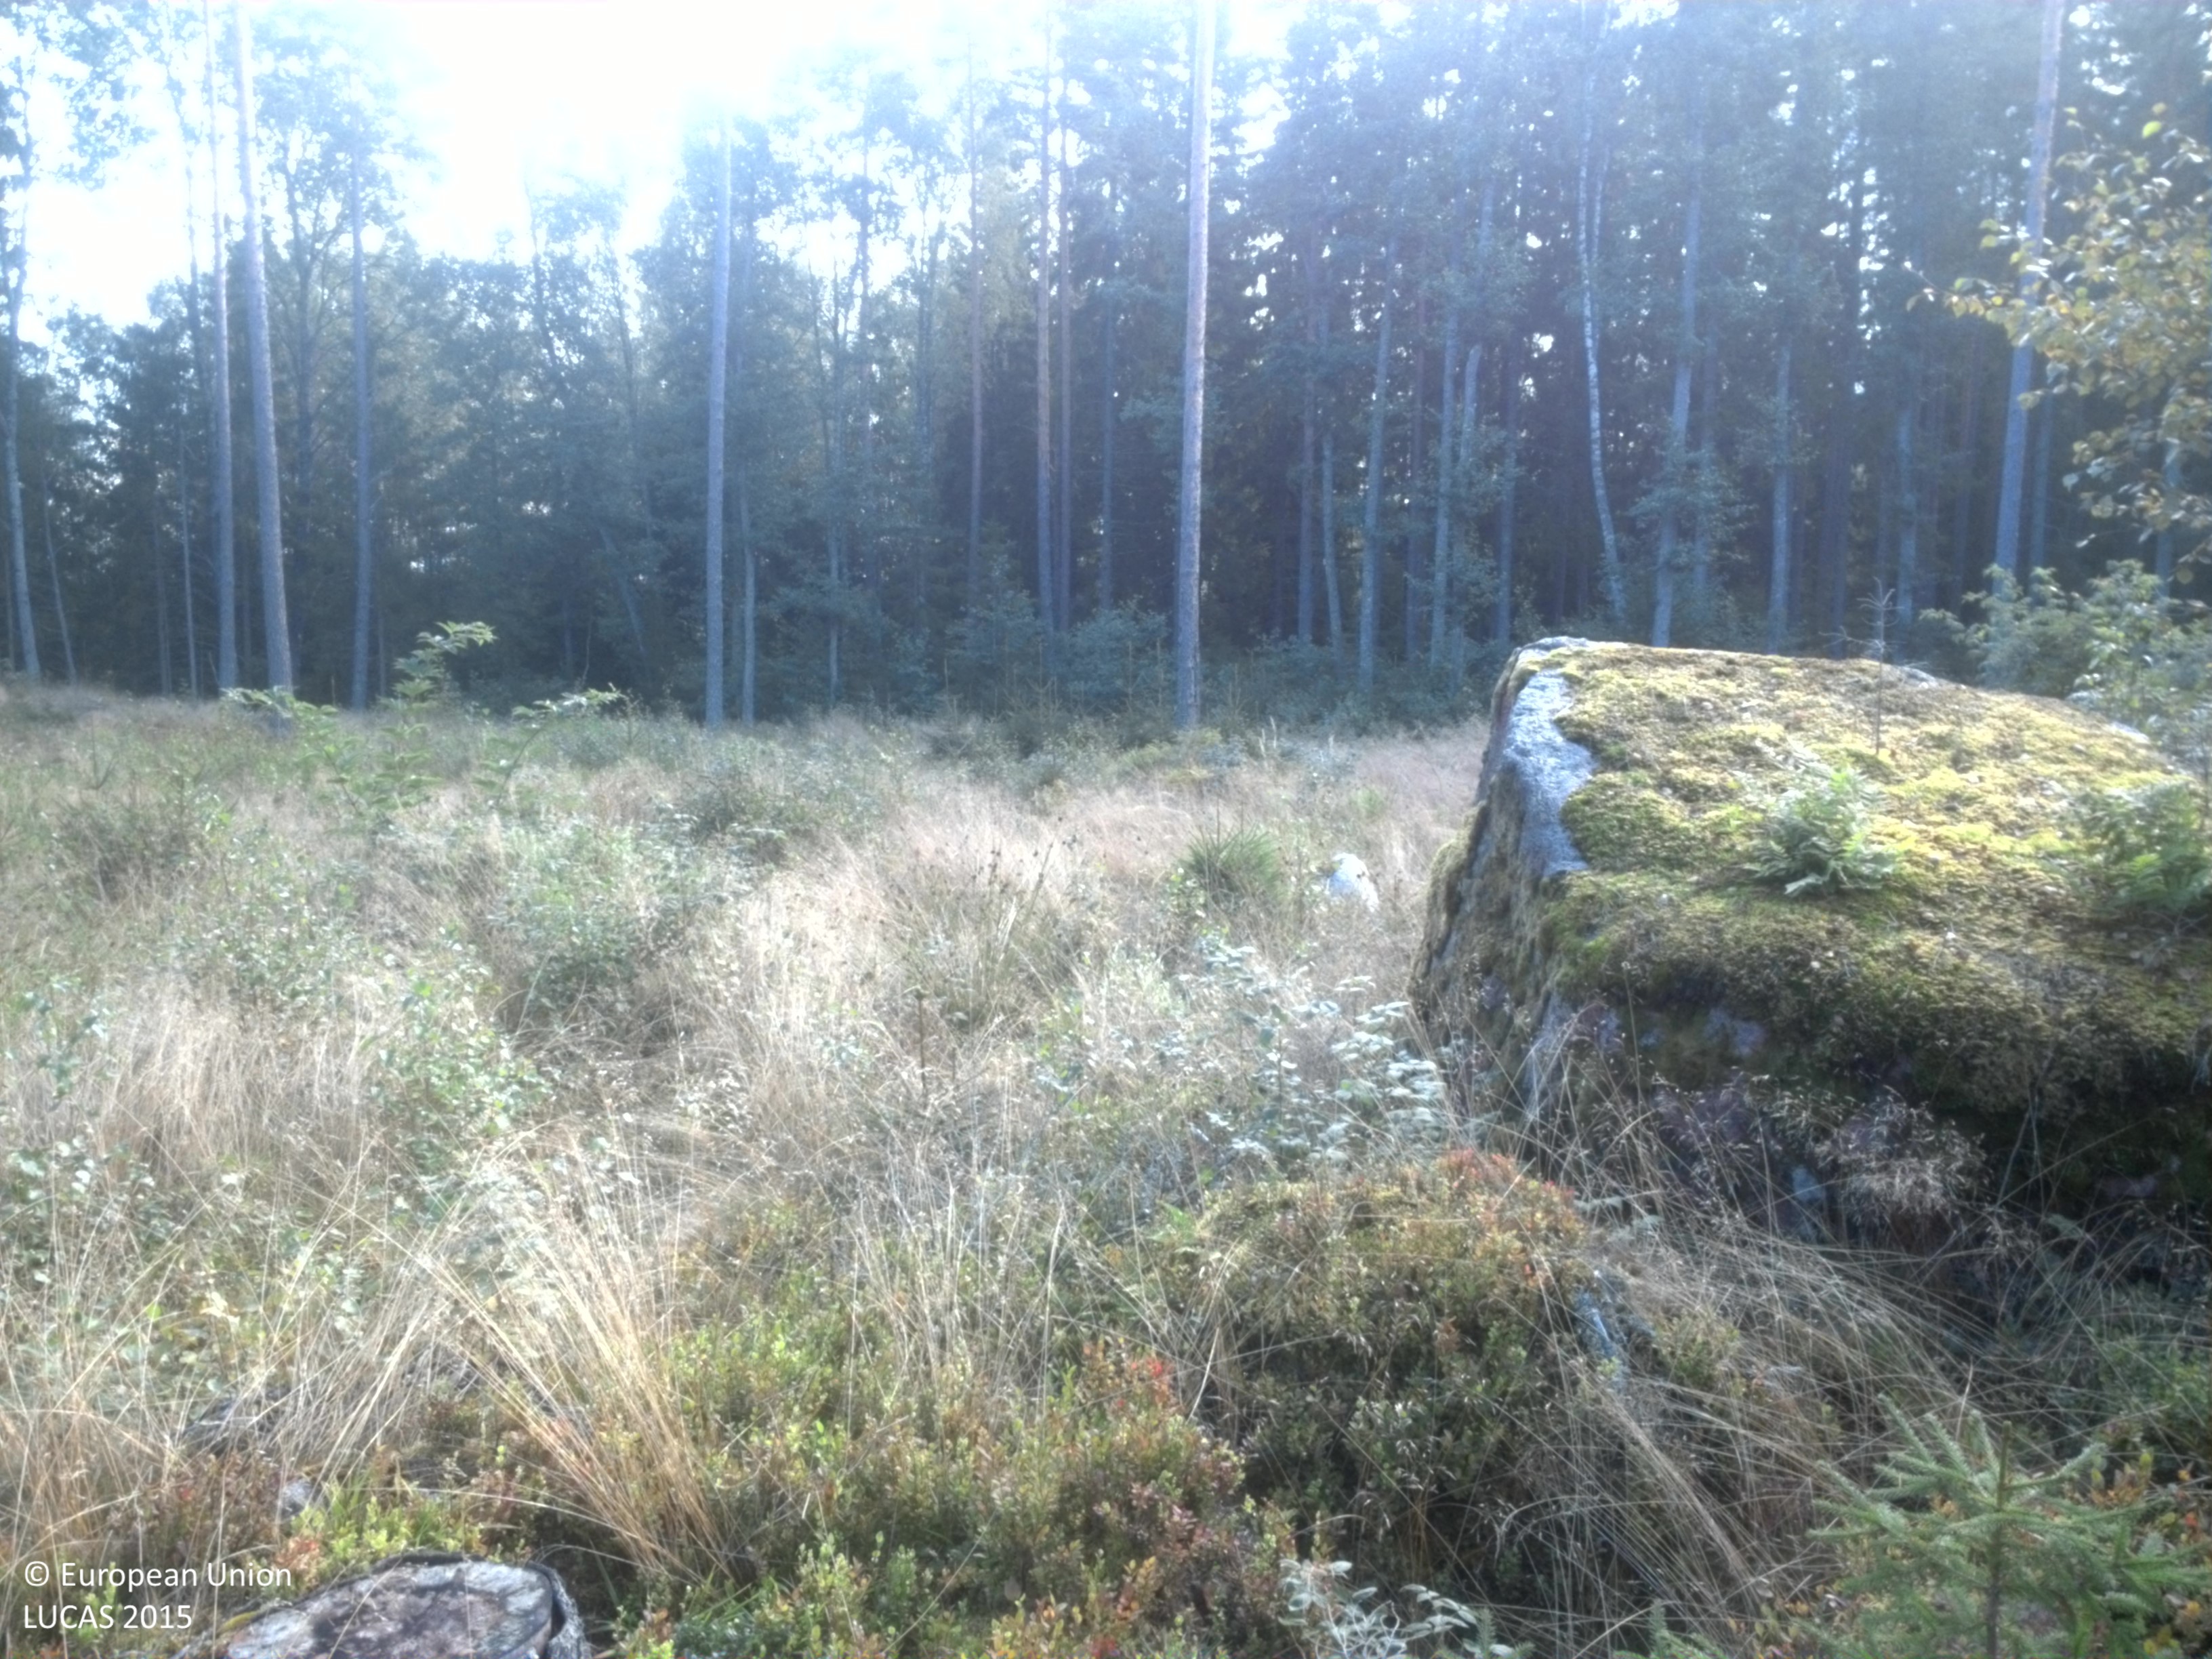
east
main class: Woodland
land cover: Pine dominated coniferous woodland
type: boreal forest
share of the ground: 50 - 75 %
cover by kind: coniferous forest trees 50 %, shrubs 25 %, herbaceous plants 15 %, broadleaved forest trees 5 %, lichens and mosses 5 %
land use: Forestry
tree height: > 5 m
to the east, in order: Pine dominated coniferous woodland; Spruce dominated coniferous woodland; Grassland with sparse tree/shrub cover; Ditches and canals; Grassland with sparse tree/shrub cover; Abandoned hedges; Common wheat
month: September
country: SE
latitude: 59.5433
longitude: 15.6686
